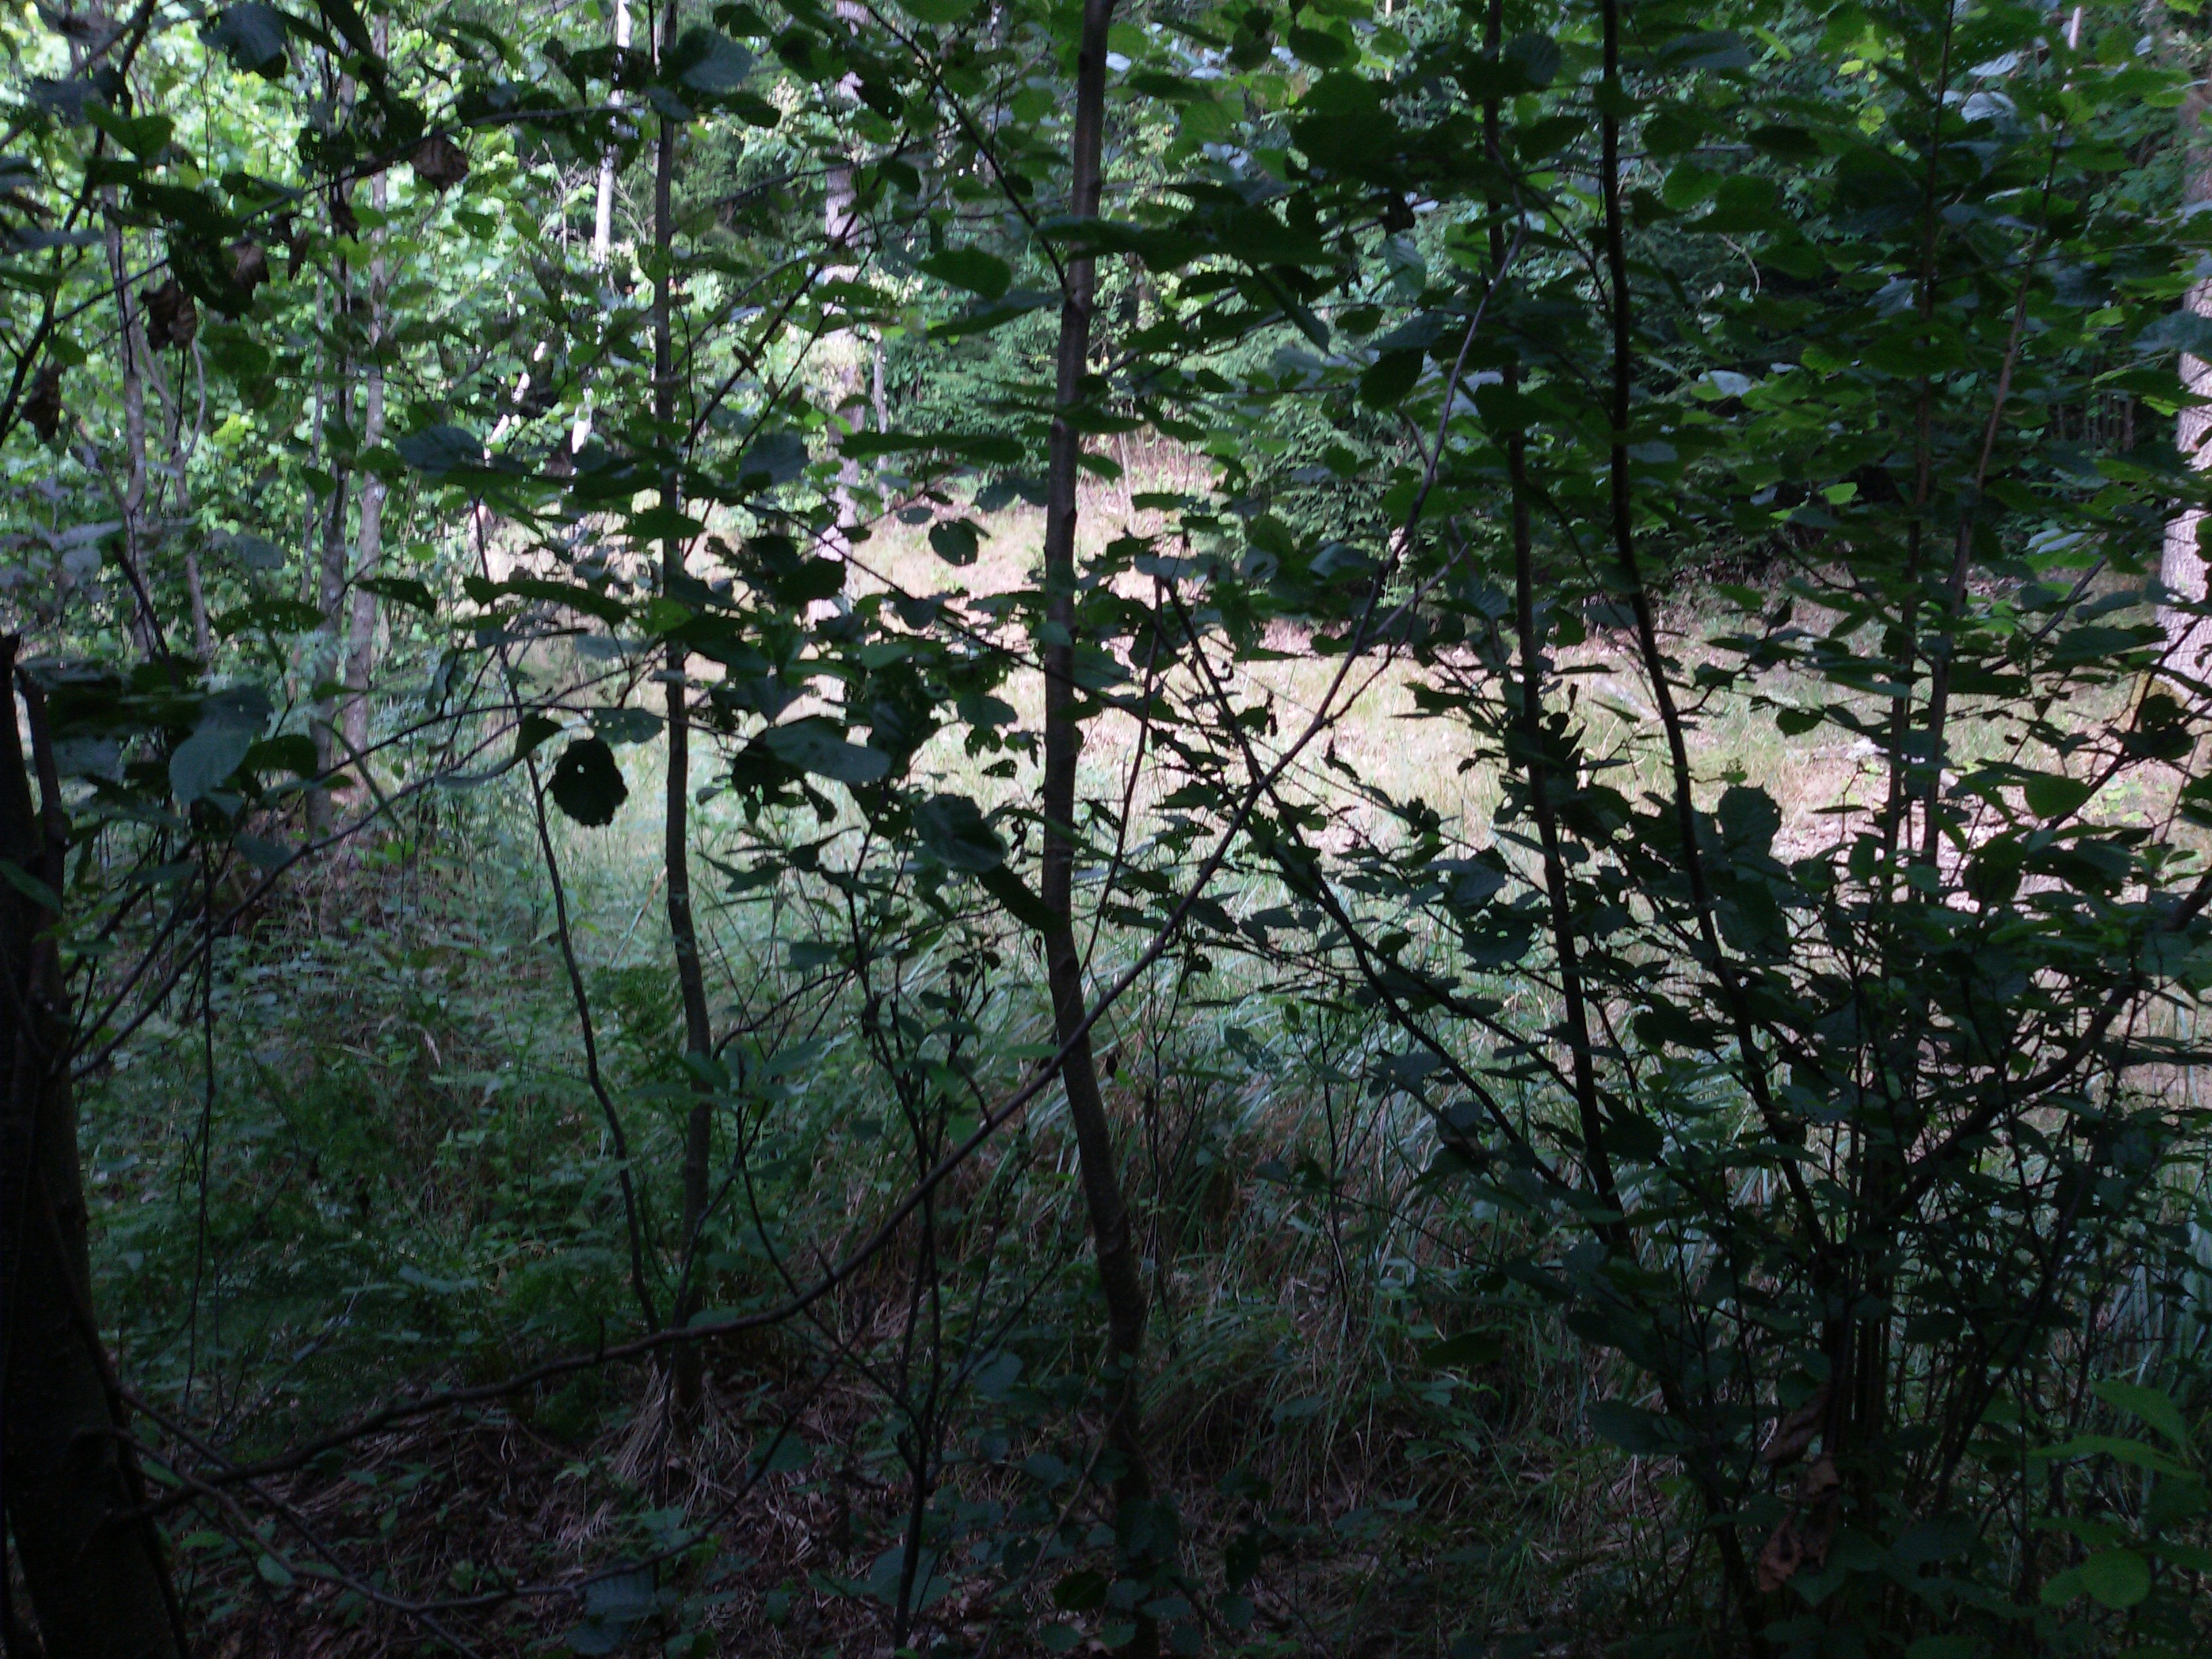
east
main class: Woodland
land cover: Broadleaved woodland
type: mesophytic deciduous forest
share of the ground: > 75 %
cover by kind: broadleaved forest trees 95 %, shrubs 5 %
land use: Semi-natural and natural areas not in use
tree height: < 5 m
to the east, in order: Broadleaved woodland; Other mixed woodland; Tracks; Other mixed woodland; Spruce dominated coniferous woodland
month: August
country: PL
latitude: 53.3032
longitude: 16.0828
